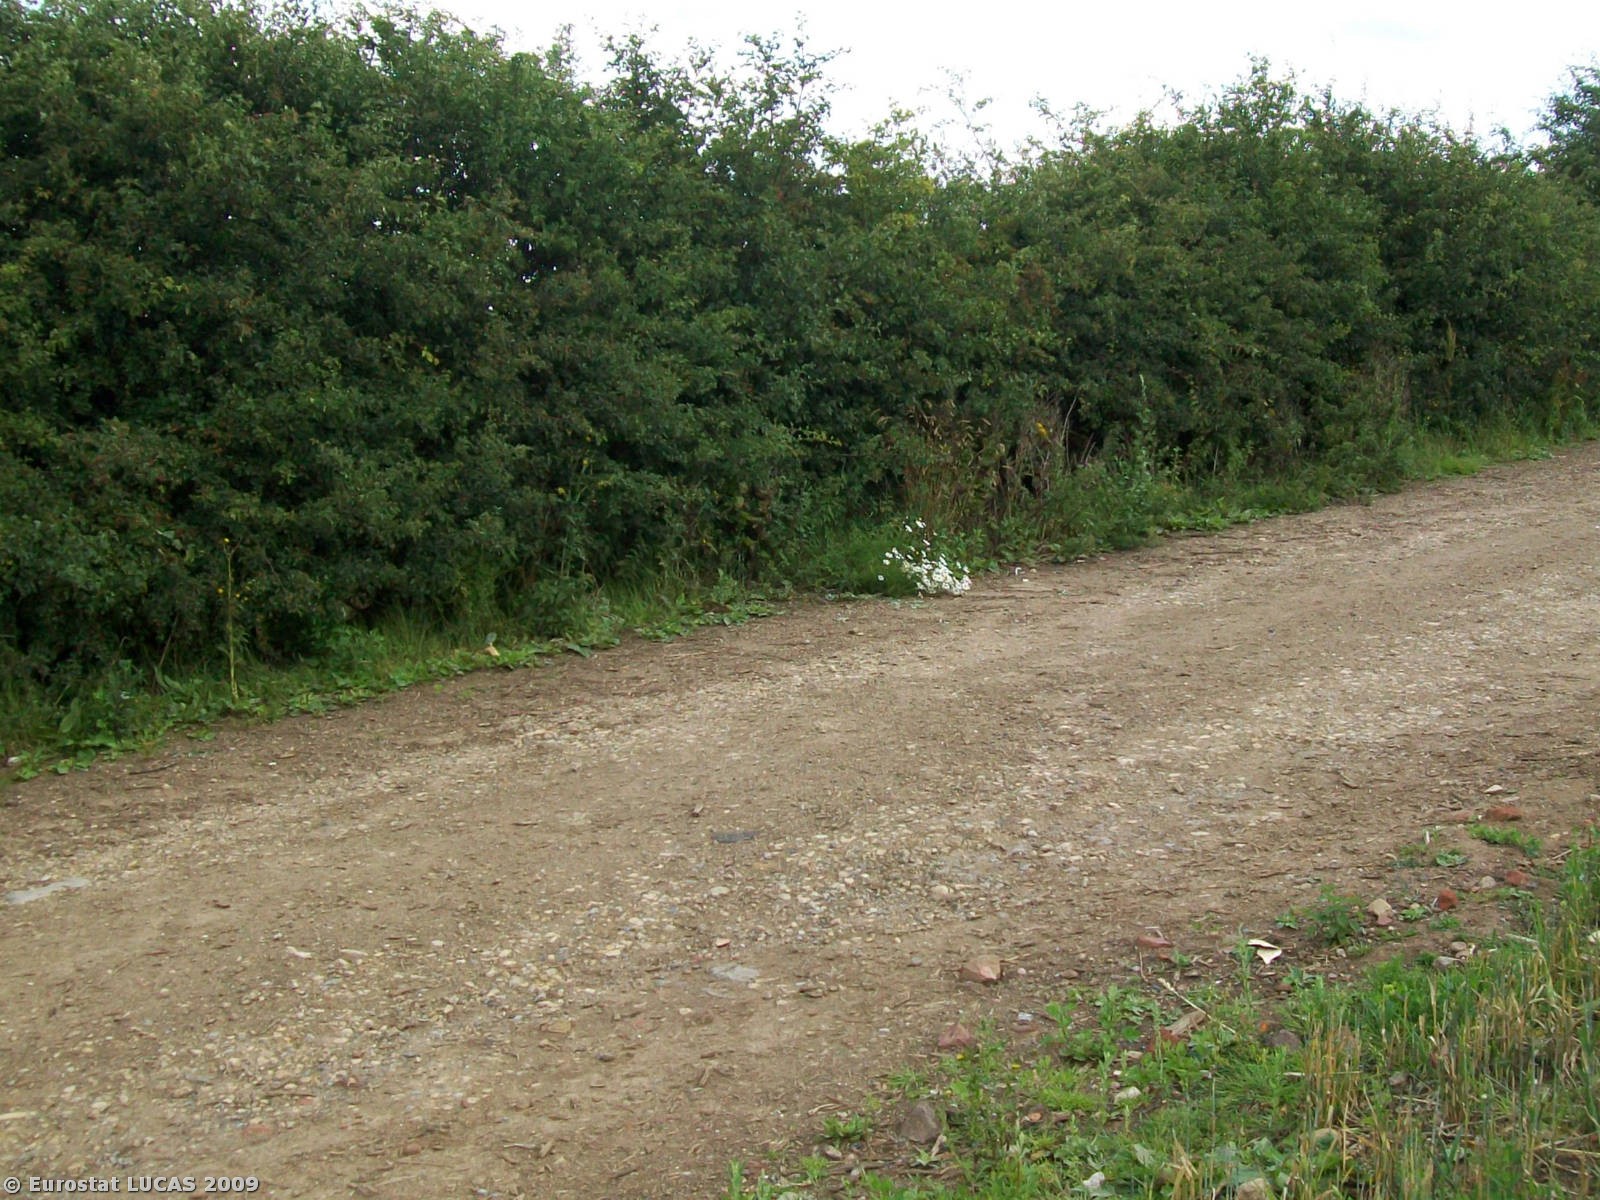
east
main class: Cropland
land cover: Common wheat
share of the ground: > 75 %
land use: Agriculture (excluding fallow land and kitchen gardens)
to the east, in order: Common wheat; Tracks; Managed hedges; Rape and turnip rape
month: July
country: GB
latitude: 53.2223
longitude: -1.2351
